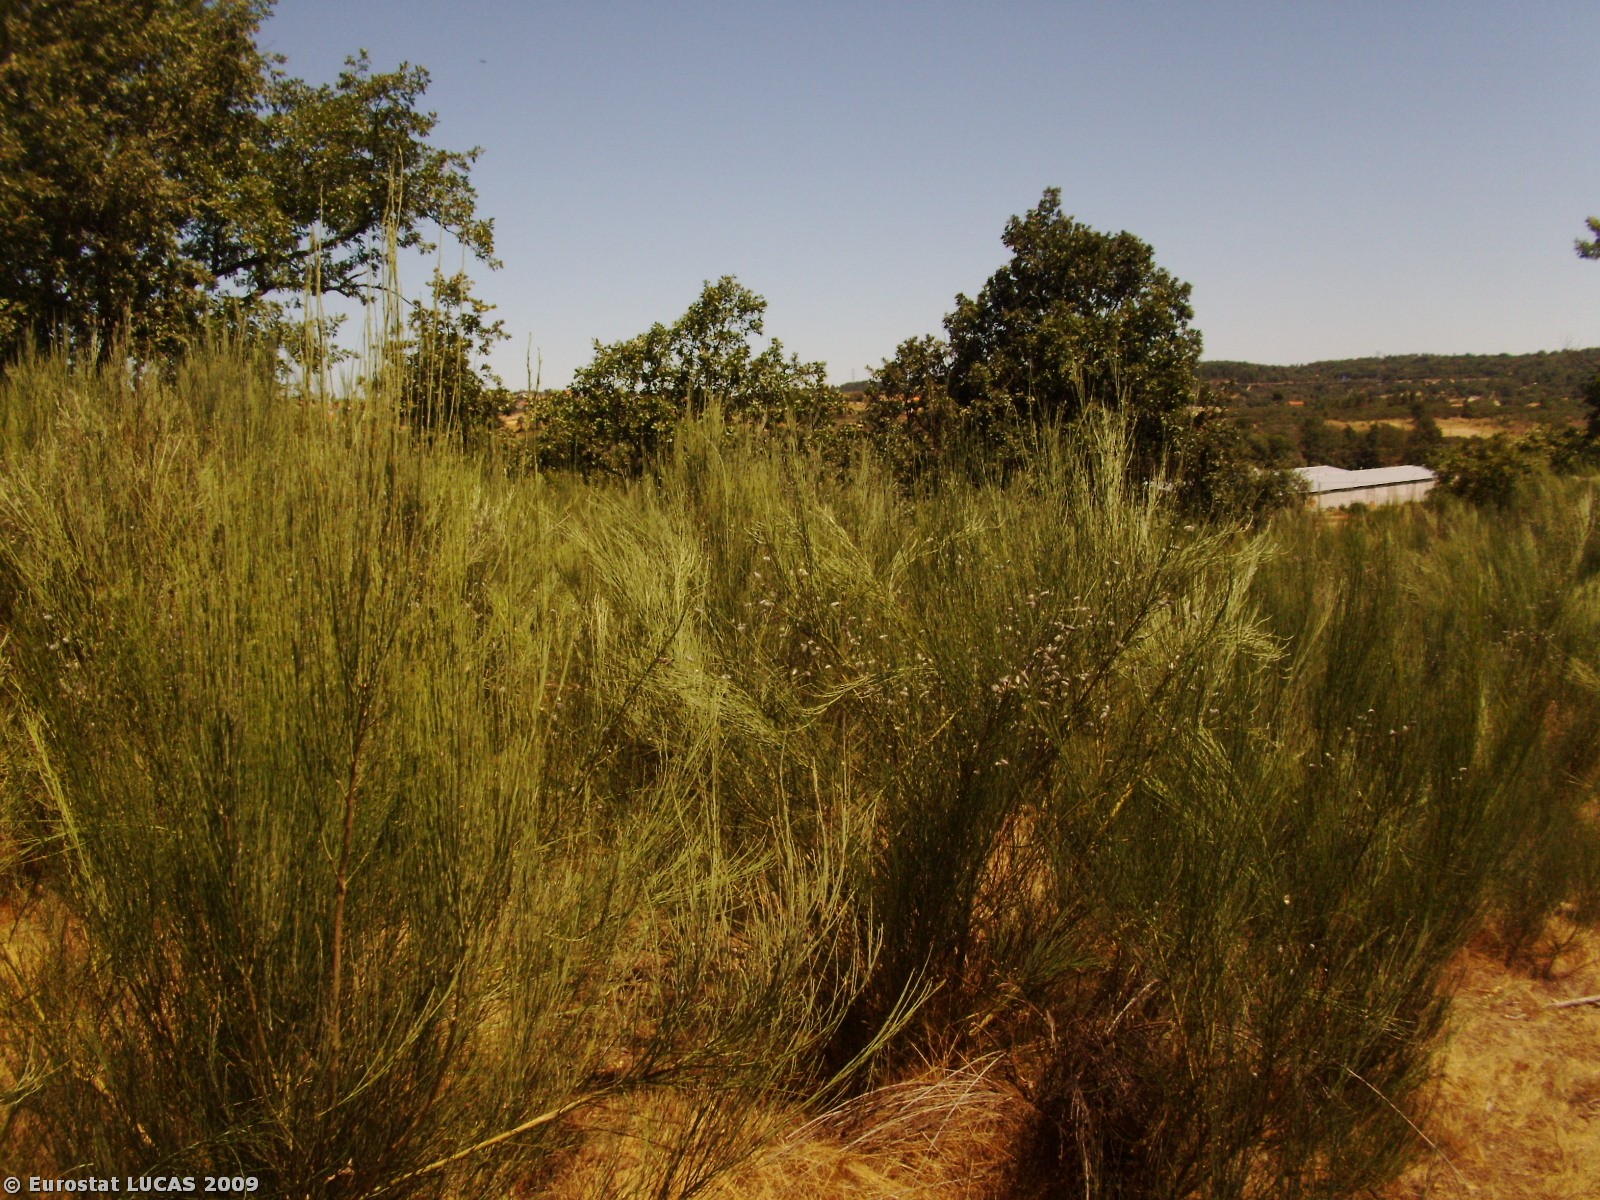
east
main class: Shrubland
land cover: Shrubland with sparse tree cover
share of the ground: > 75 %
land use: Forestry
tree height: > 5 m
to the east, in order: Shrubland with sparse tree cover; Broadleaved woodland; Spontaneously vegetated surfaces; Railways
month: July
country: PT
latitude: 40.5366
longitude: -7.2358
